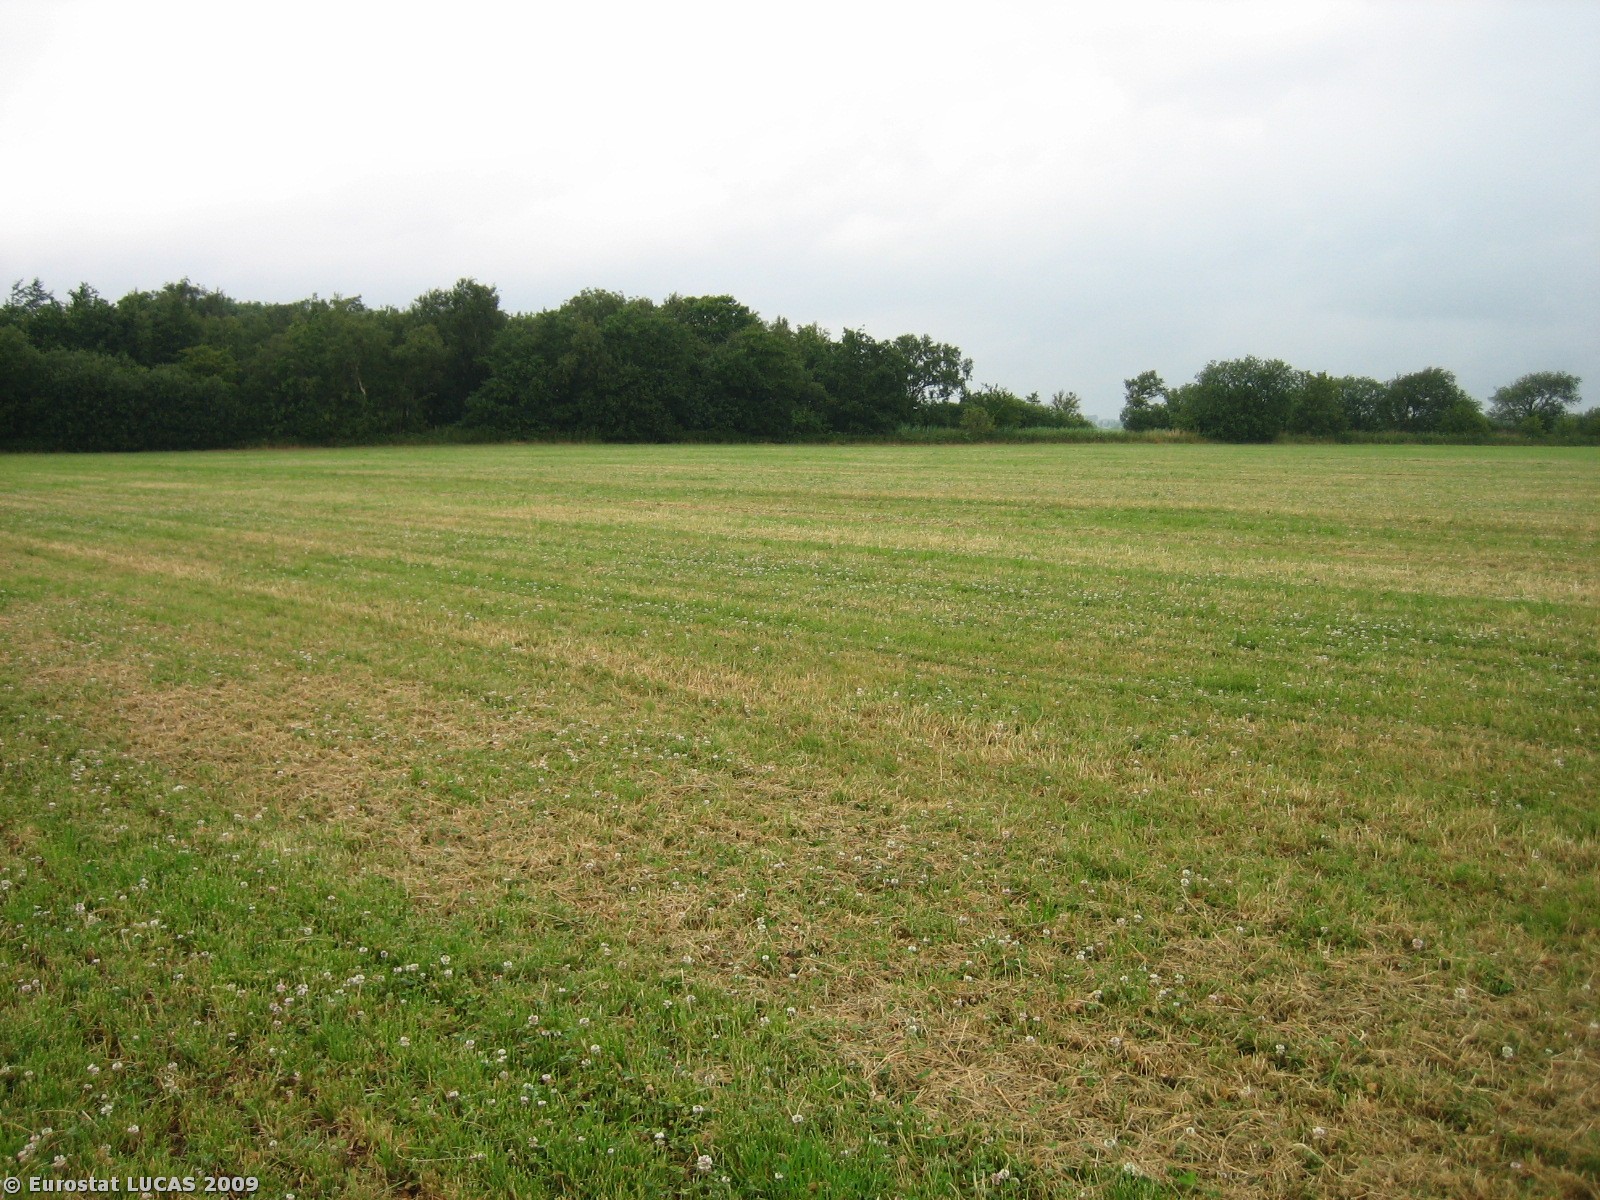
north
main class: Cropland
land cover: Temporary grasslands
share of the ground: > 75 %
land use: Agriculture (excluding fallow land and kitchen gardens)
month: July
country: DK
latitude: 55.4437
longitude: 8.6575
